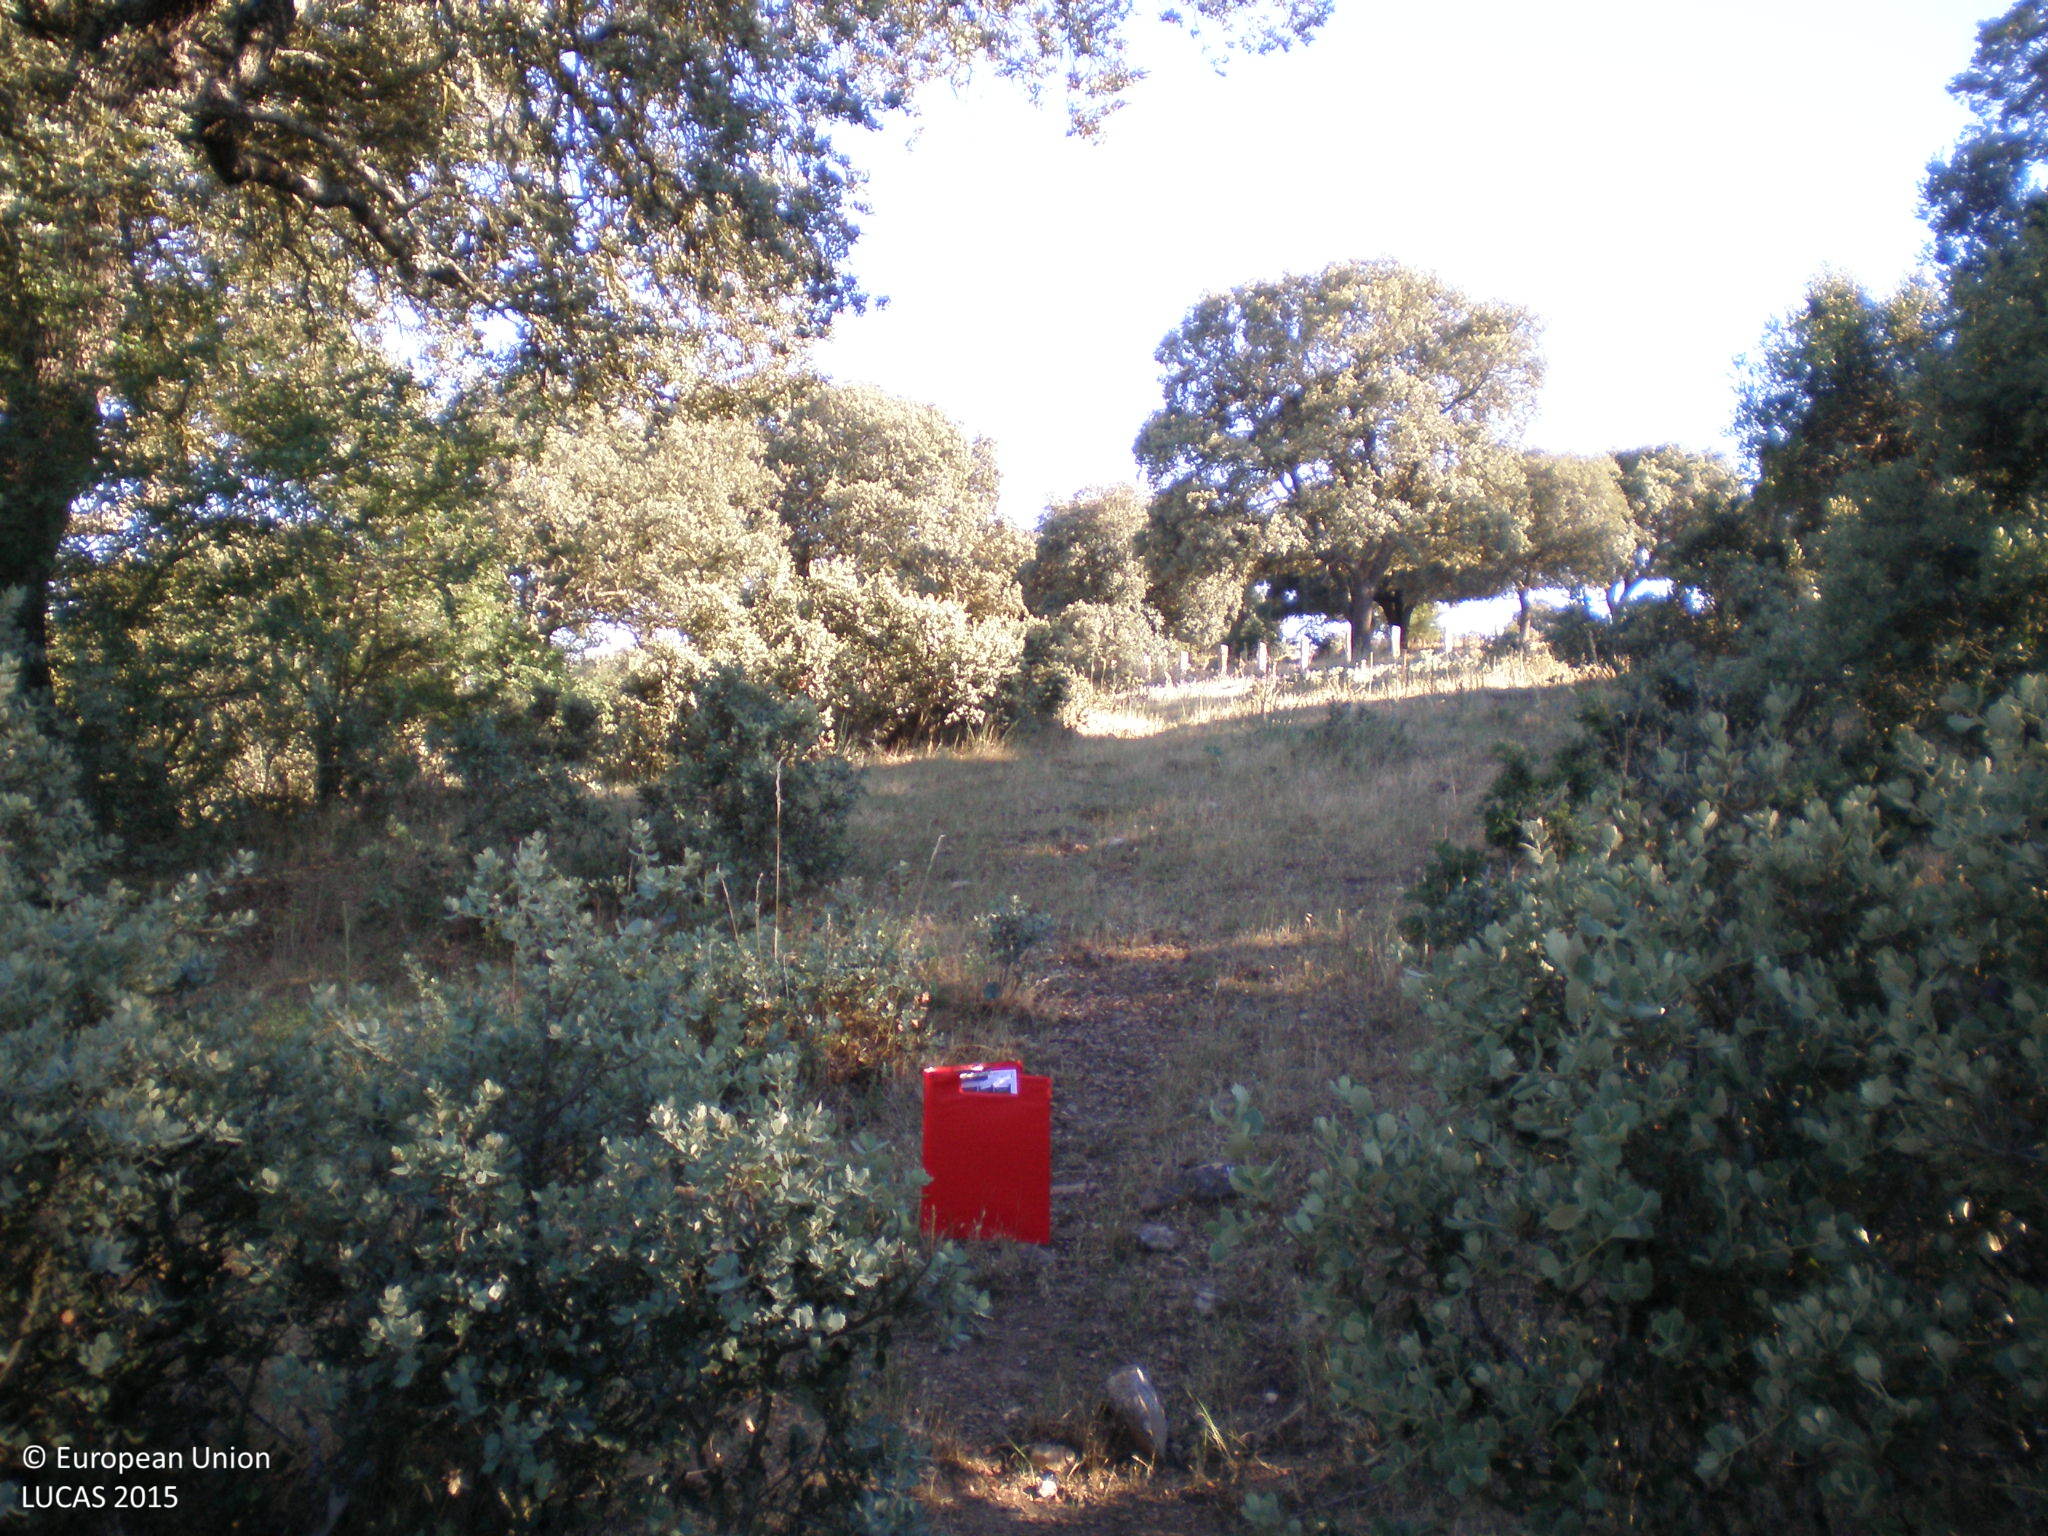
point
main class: Woodland
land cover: Broadleaved woodland
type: broadleaved evergreen forest
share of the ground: 50 - 75 %
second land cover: Grassland without tree/shrub cover
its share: 25 - 50 %
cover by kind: broadleaved forest trees 55 %, herbaceous plants 45 %
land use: Forestry
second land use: Agriculture (excluding fallow land and kitchen gardens)
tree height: > 5 m
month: June
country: ES
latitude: 40.7456
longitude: -5.6715
